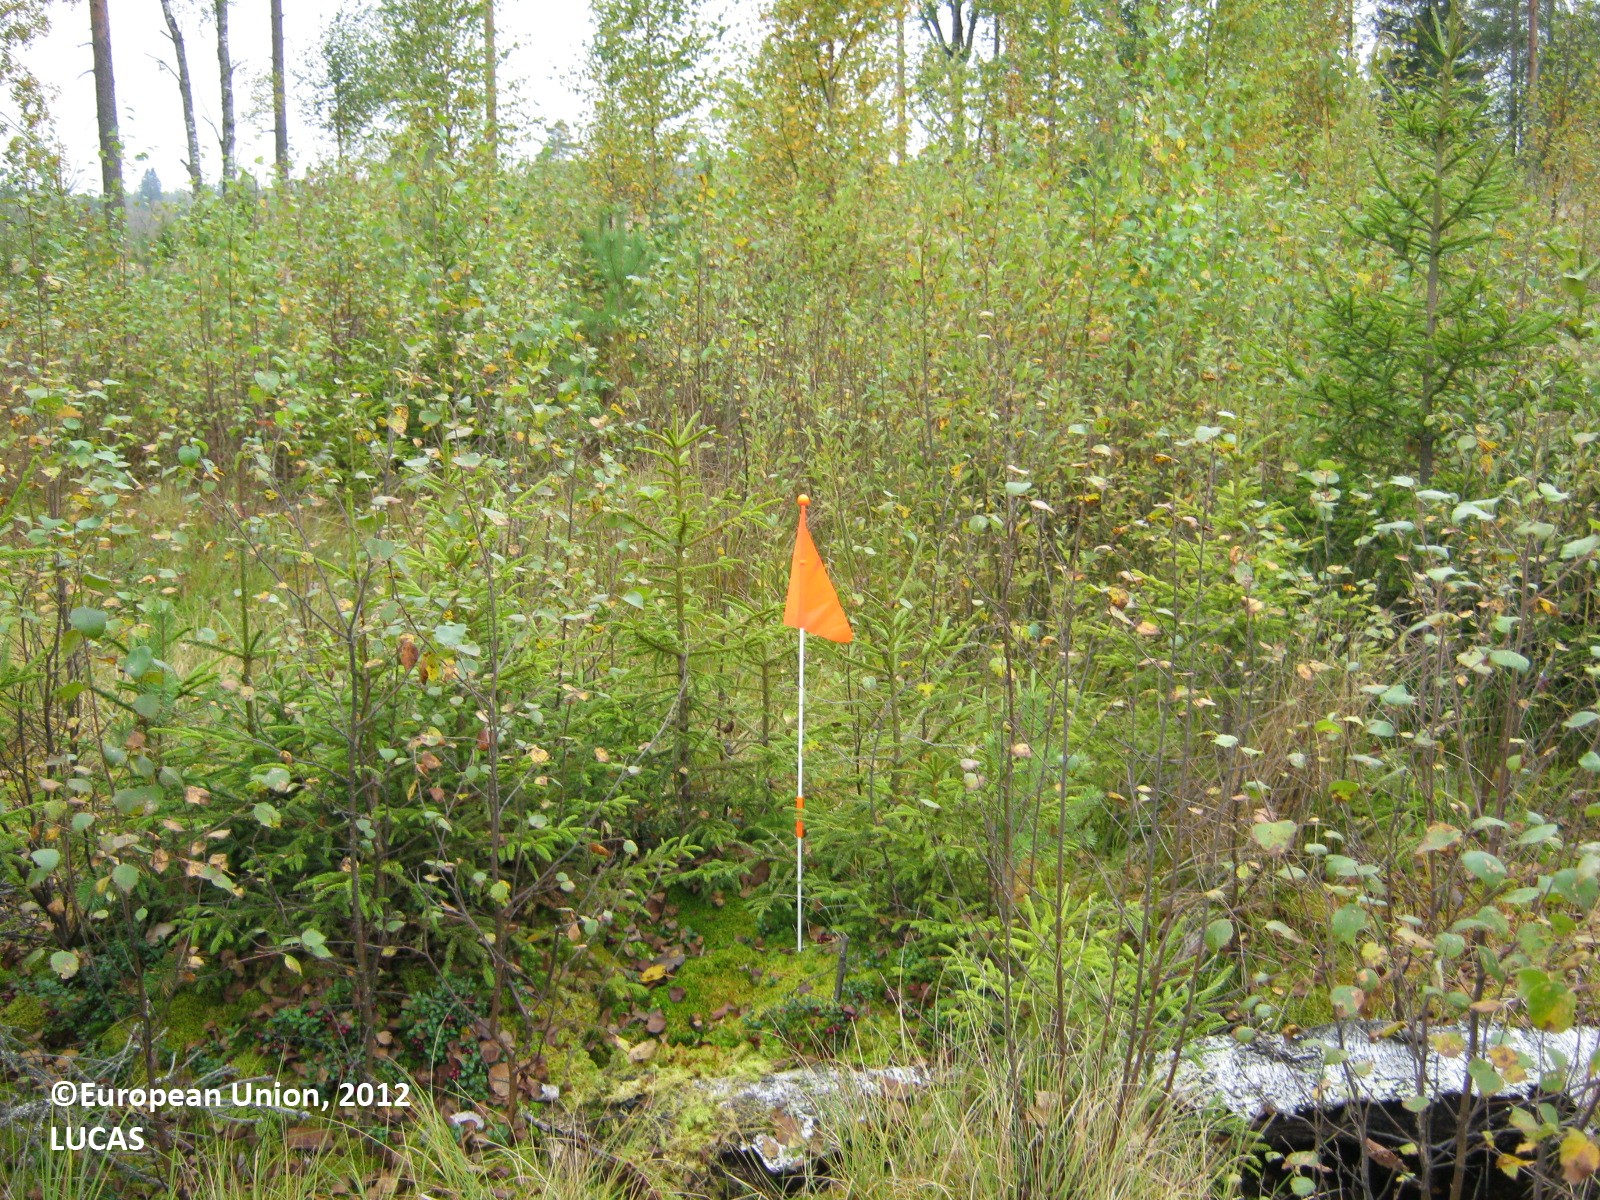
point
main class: Woodland
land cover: Broadleaved woodland
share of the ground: > 75 %
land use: Forestry
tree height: < 5 m
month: September
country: FI
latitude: 61.0228
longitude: 27.9039
